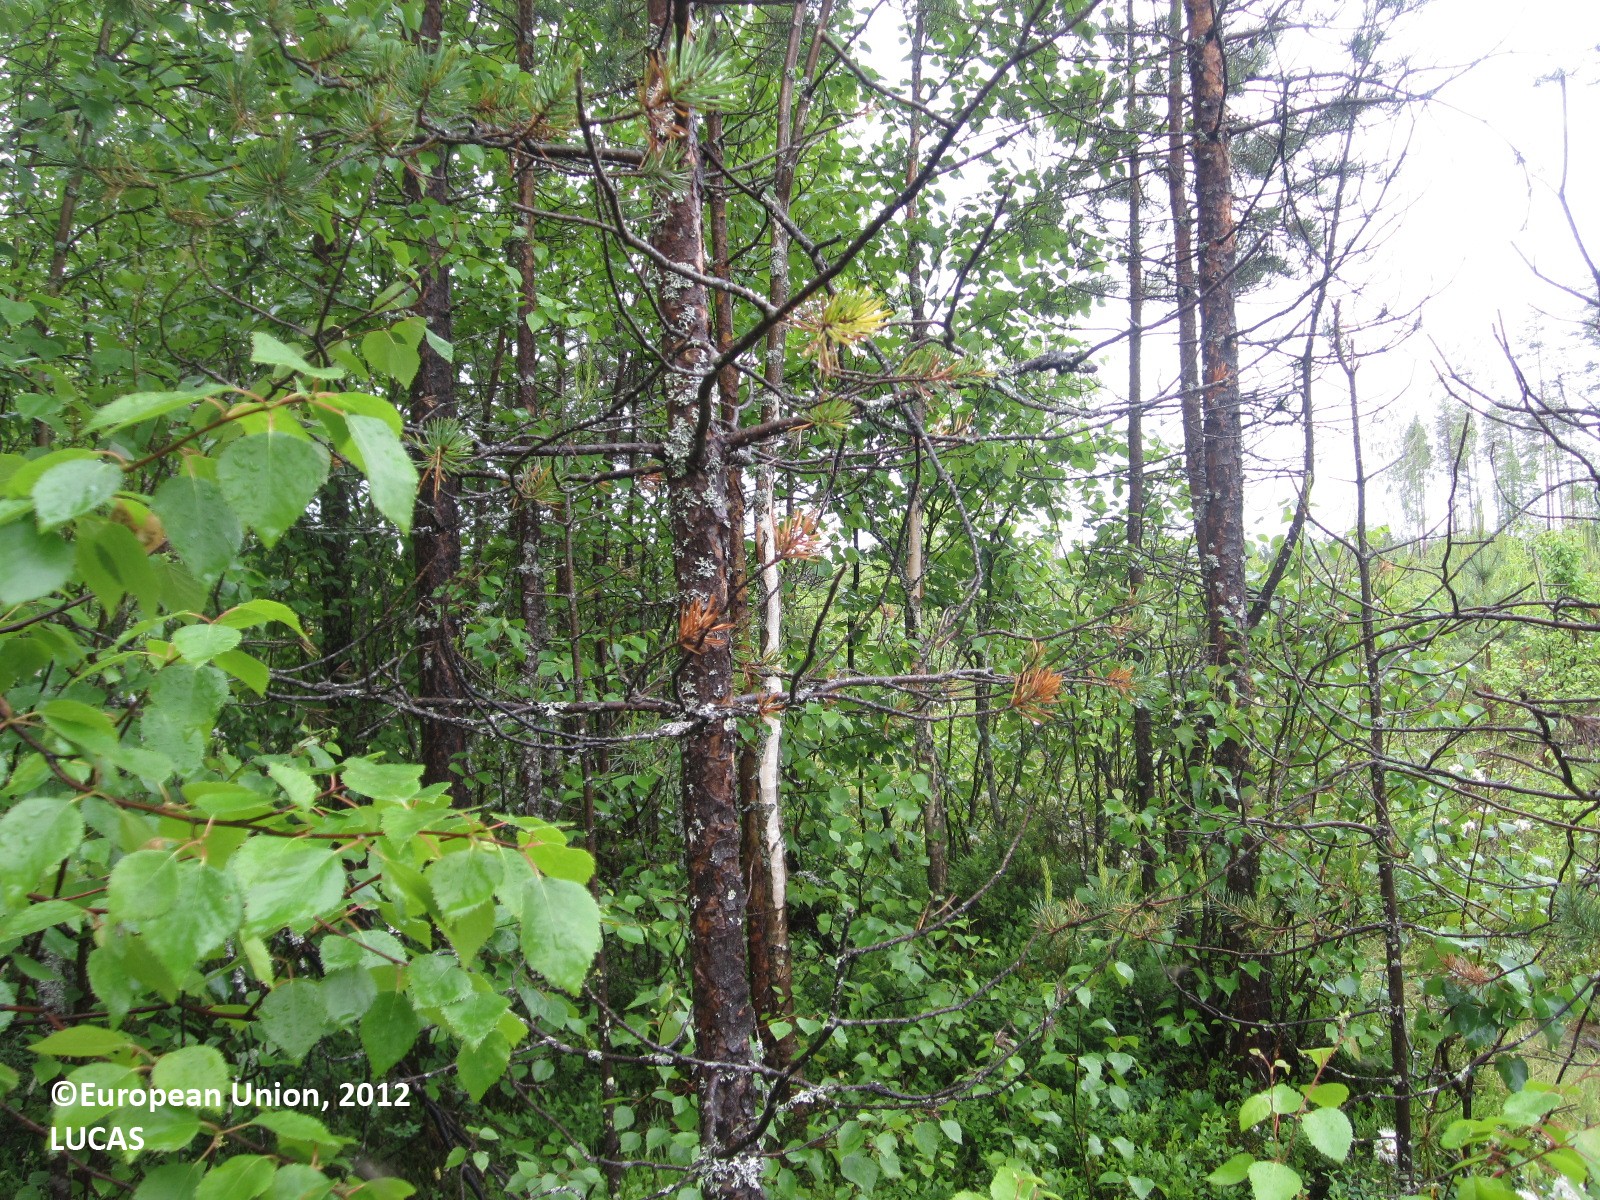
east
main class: Woodland
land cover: Pine dominated mixed woodland
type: boreal forest
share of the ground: 50 - 75 %
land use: Forestry
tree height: > 5 m
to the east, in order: Pine dominated mixed woodland; Tracks; Pine dominated mixed woodland; Pine dominated coniferous woodland; Pine dominated mixed woodland; Pine dominated coniferous woodland; Pine dominated mixed woodland; Tracks; Pine dominated mixed woodland; Ditches and canals; Pine dominated mixed woodland; Ditches and canals; Pine dominated coniferous woodland
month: June
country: FI
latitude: 64.3298
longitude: 29.6497
